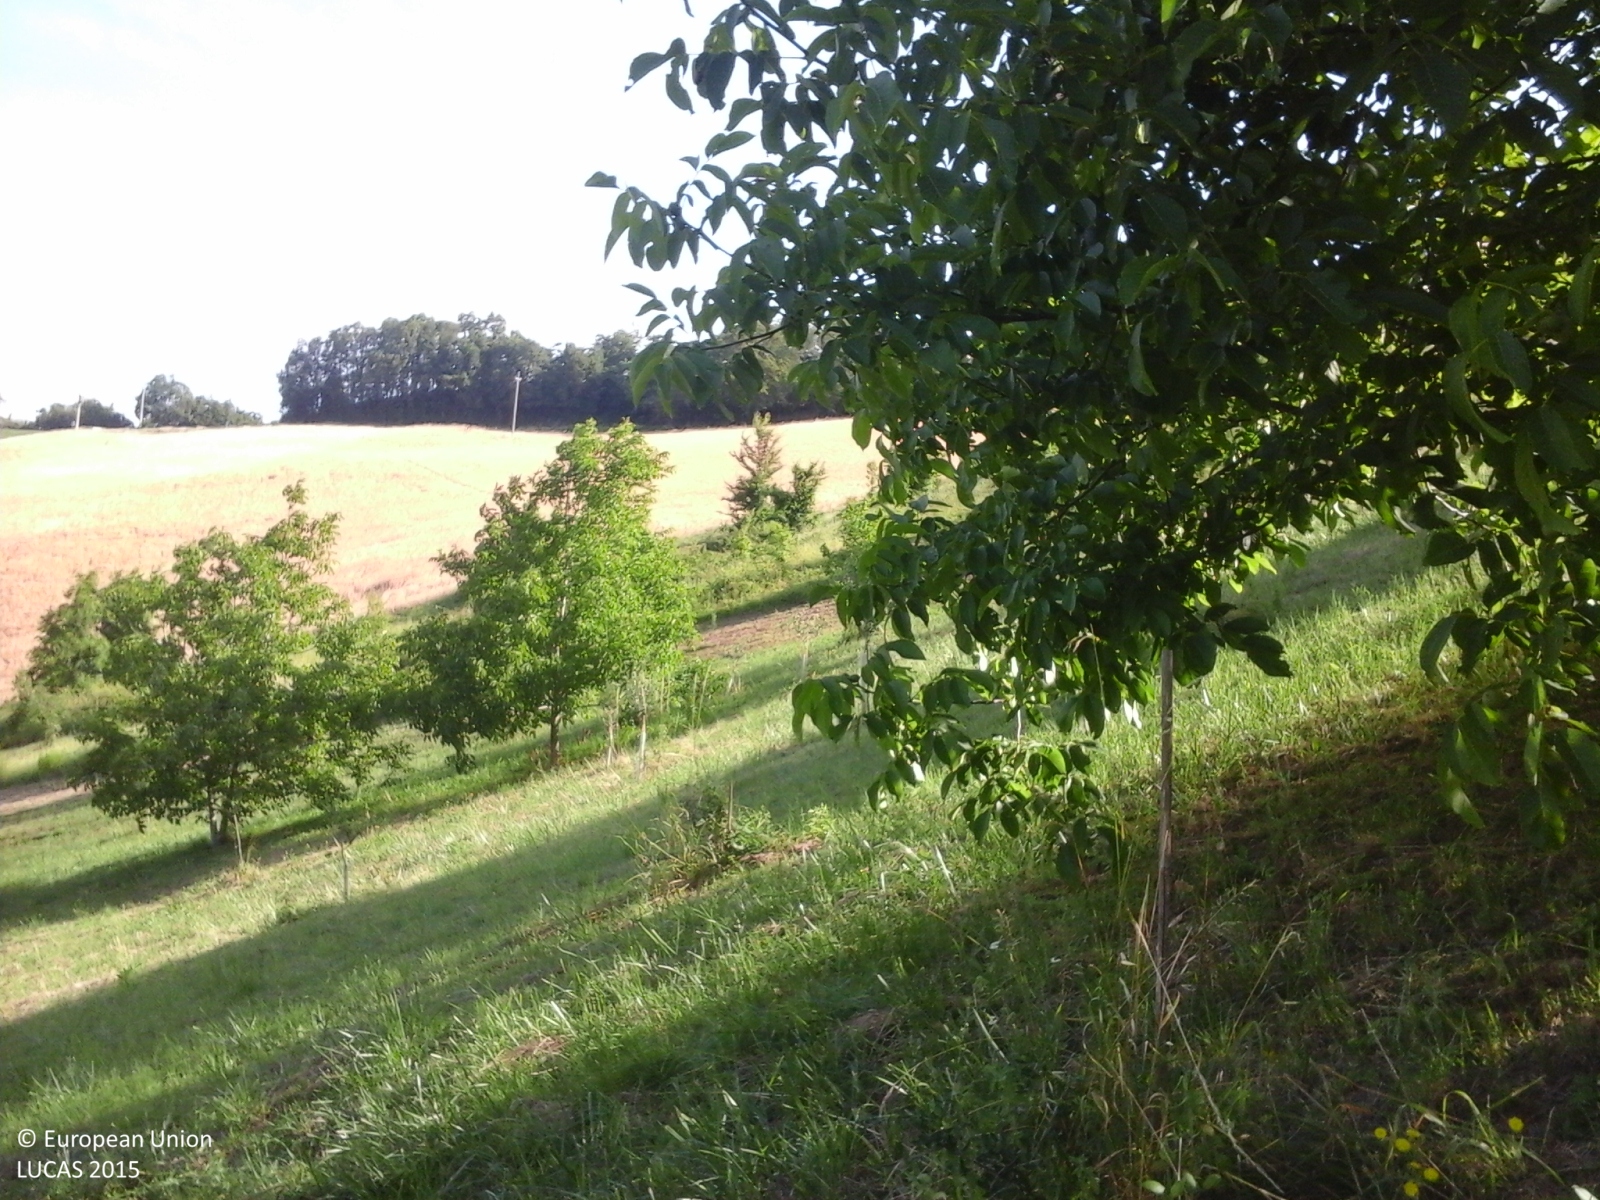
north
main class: Grassland
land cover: Grassland with sparse tree/shrub cover
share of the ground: > 75 %
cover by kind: herbaceous plants 95 %, broadleaved forest trees 5 %
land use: Agriculture (excluding fallow land and kitchen gardens)
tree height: > 5 m
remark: Clear cut
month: June
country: IT
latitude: 44.6205
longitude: 10.3395
